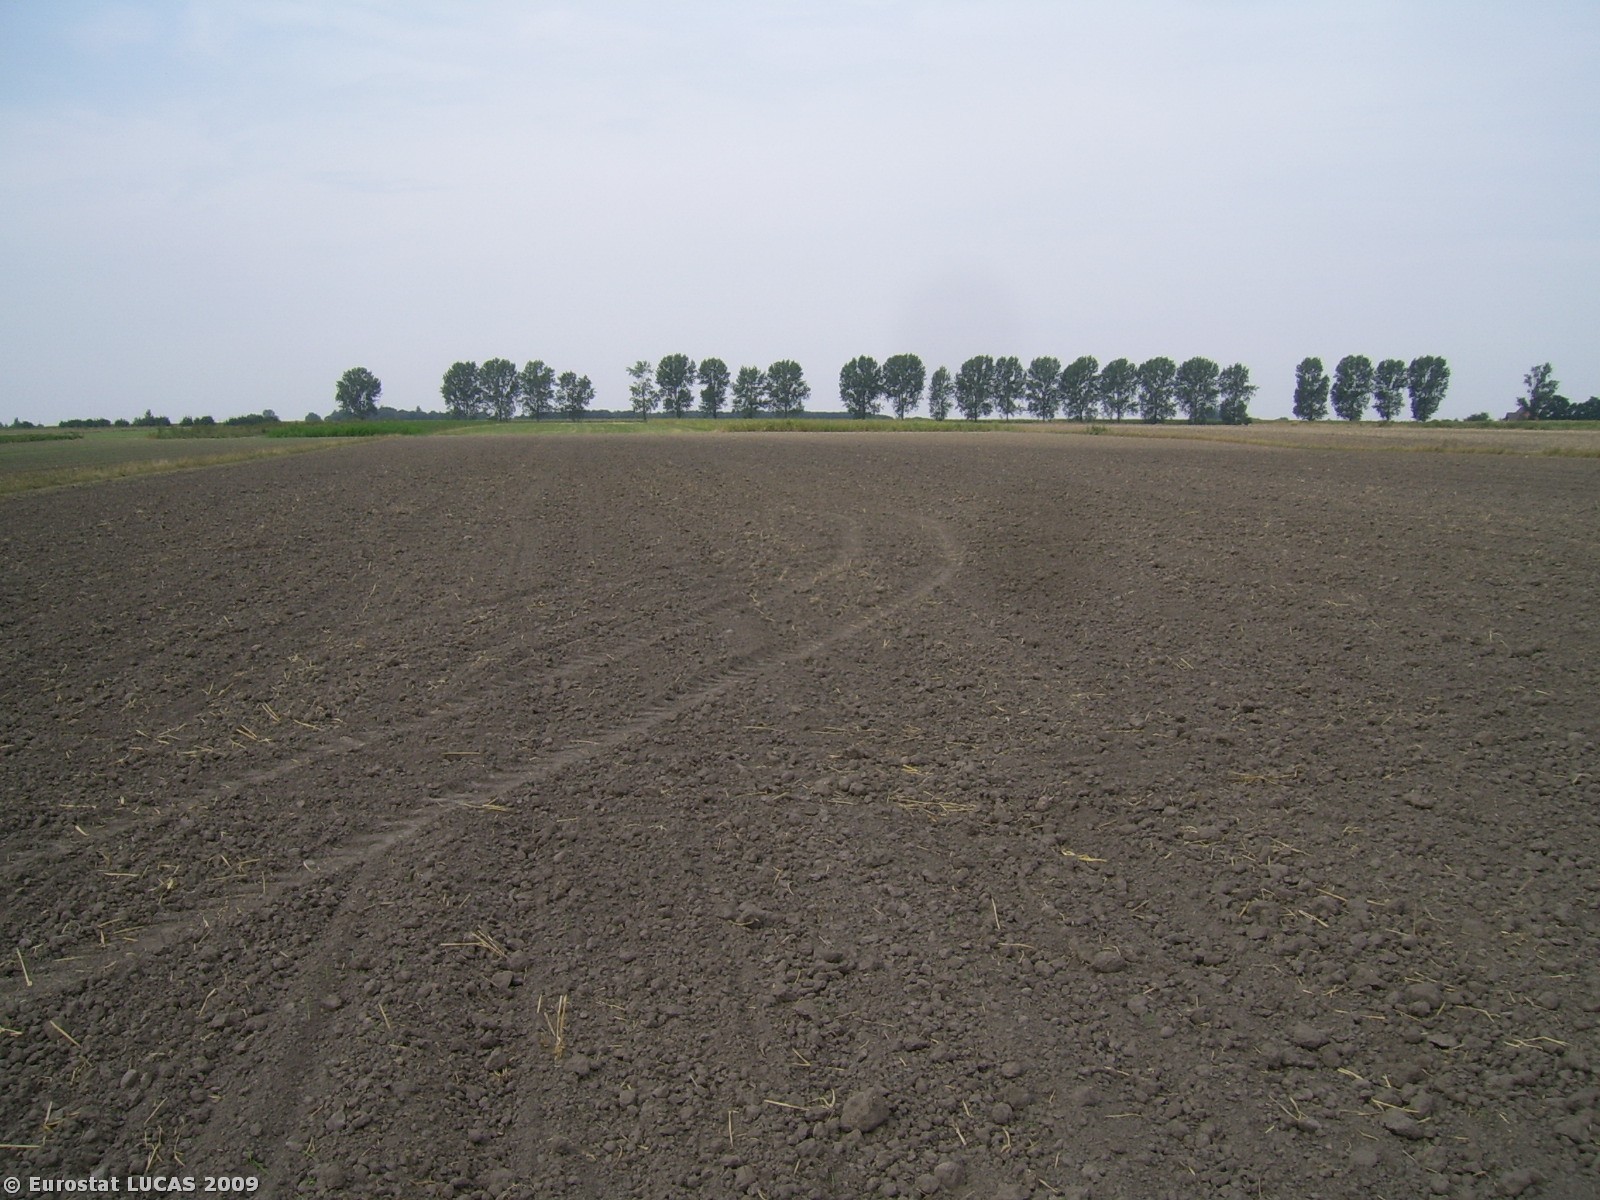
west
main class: Cropland
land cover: Mixed cereals for fodder
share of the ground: < 10 %
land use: Agriculture (excluding fallow land and kitchen gardens)
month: August
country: PL
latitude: 51.7316
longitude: 18.4604
